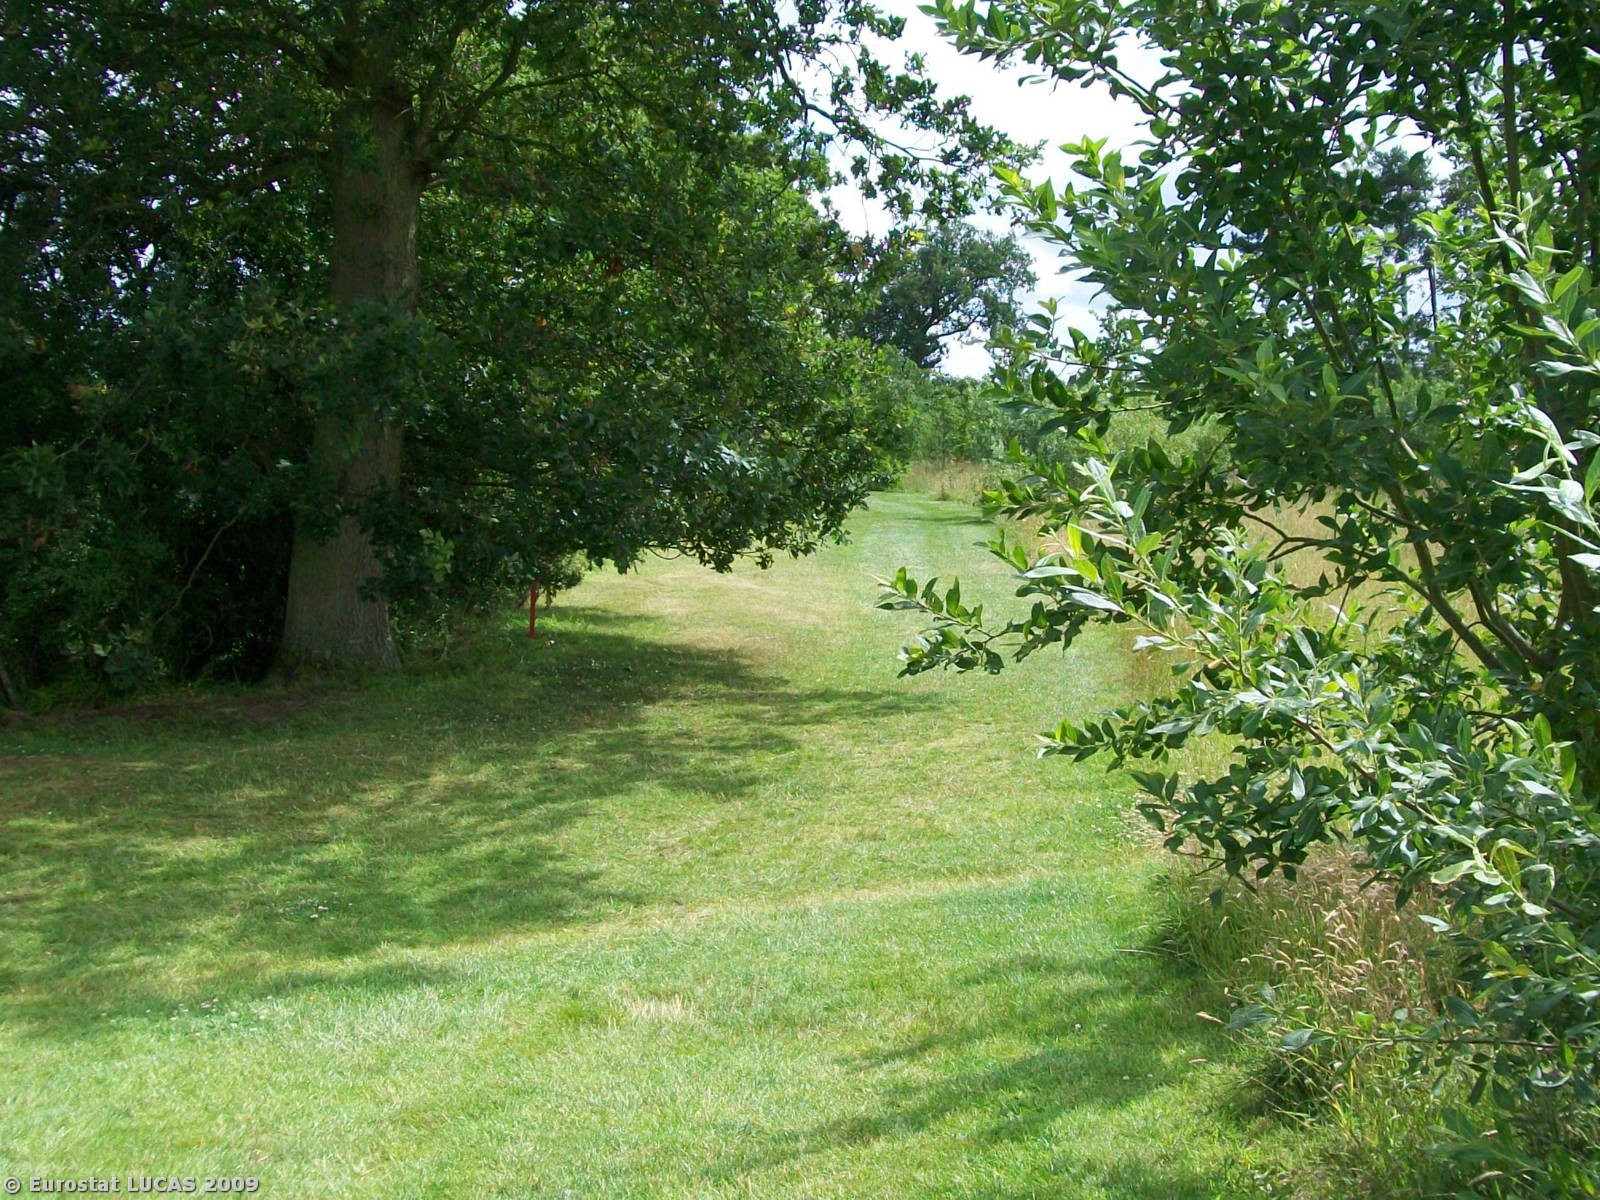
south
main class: Grassland
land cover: Grassland with sparse tree/shrub cover
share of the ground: > 75 %
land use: Sport
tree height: > 5 m
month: July
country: GB
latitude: 51.3752
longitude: -2.2594
